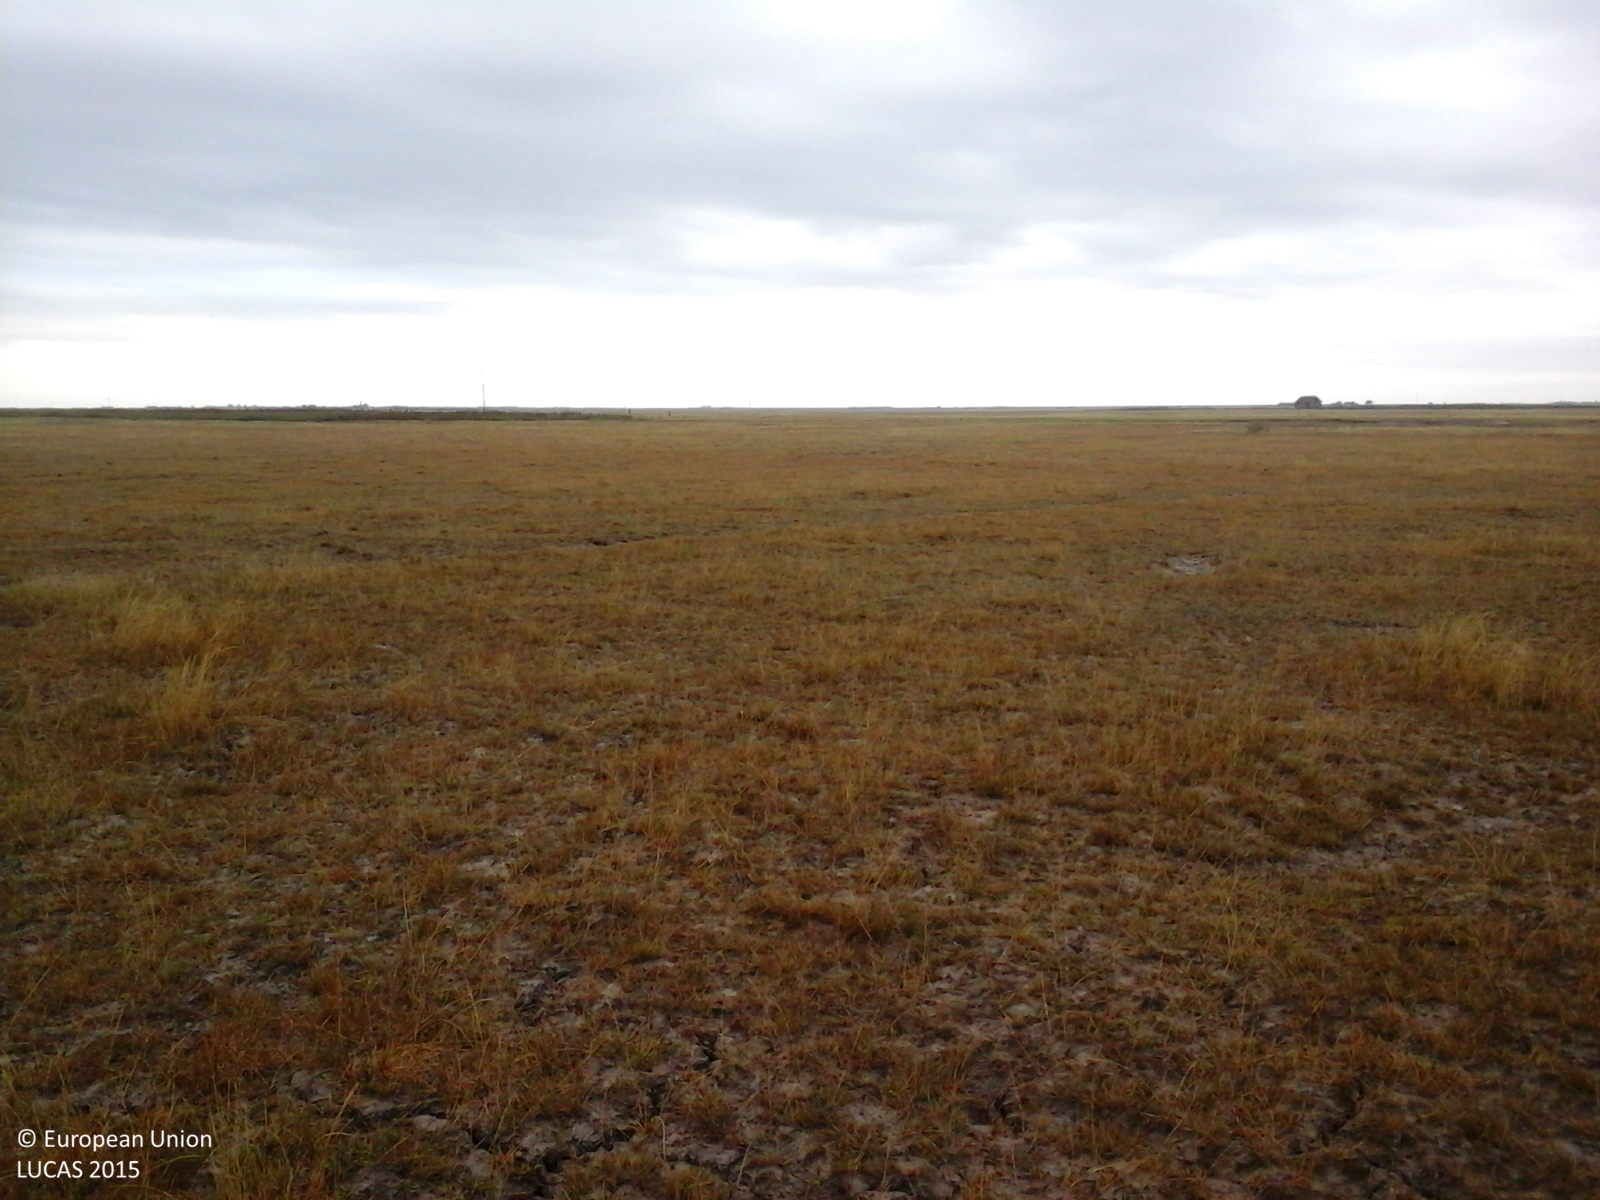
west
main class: Grassland
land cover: Grassland without tree/shrub cover
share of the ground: > 75 %
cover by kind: herbaceous plants 100 %
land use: Agriculture (excluding fallow land and kitchen gardens)
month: August
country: RO
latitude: 45.5811
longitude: 21.0105
